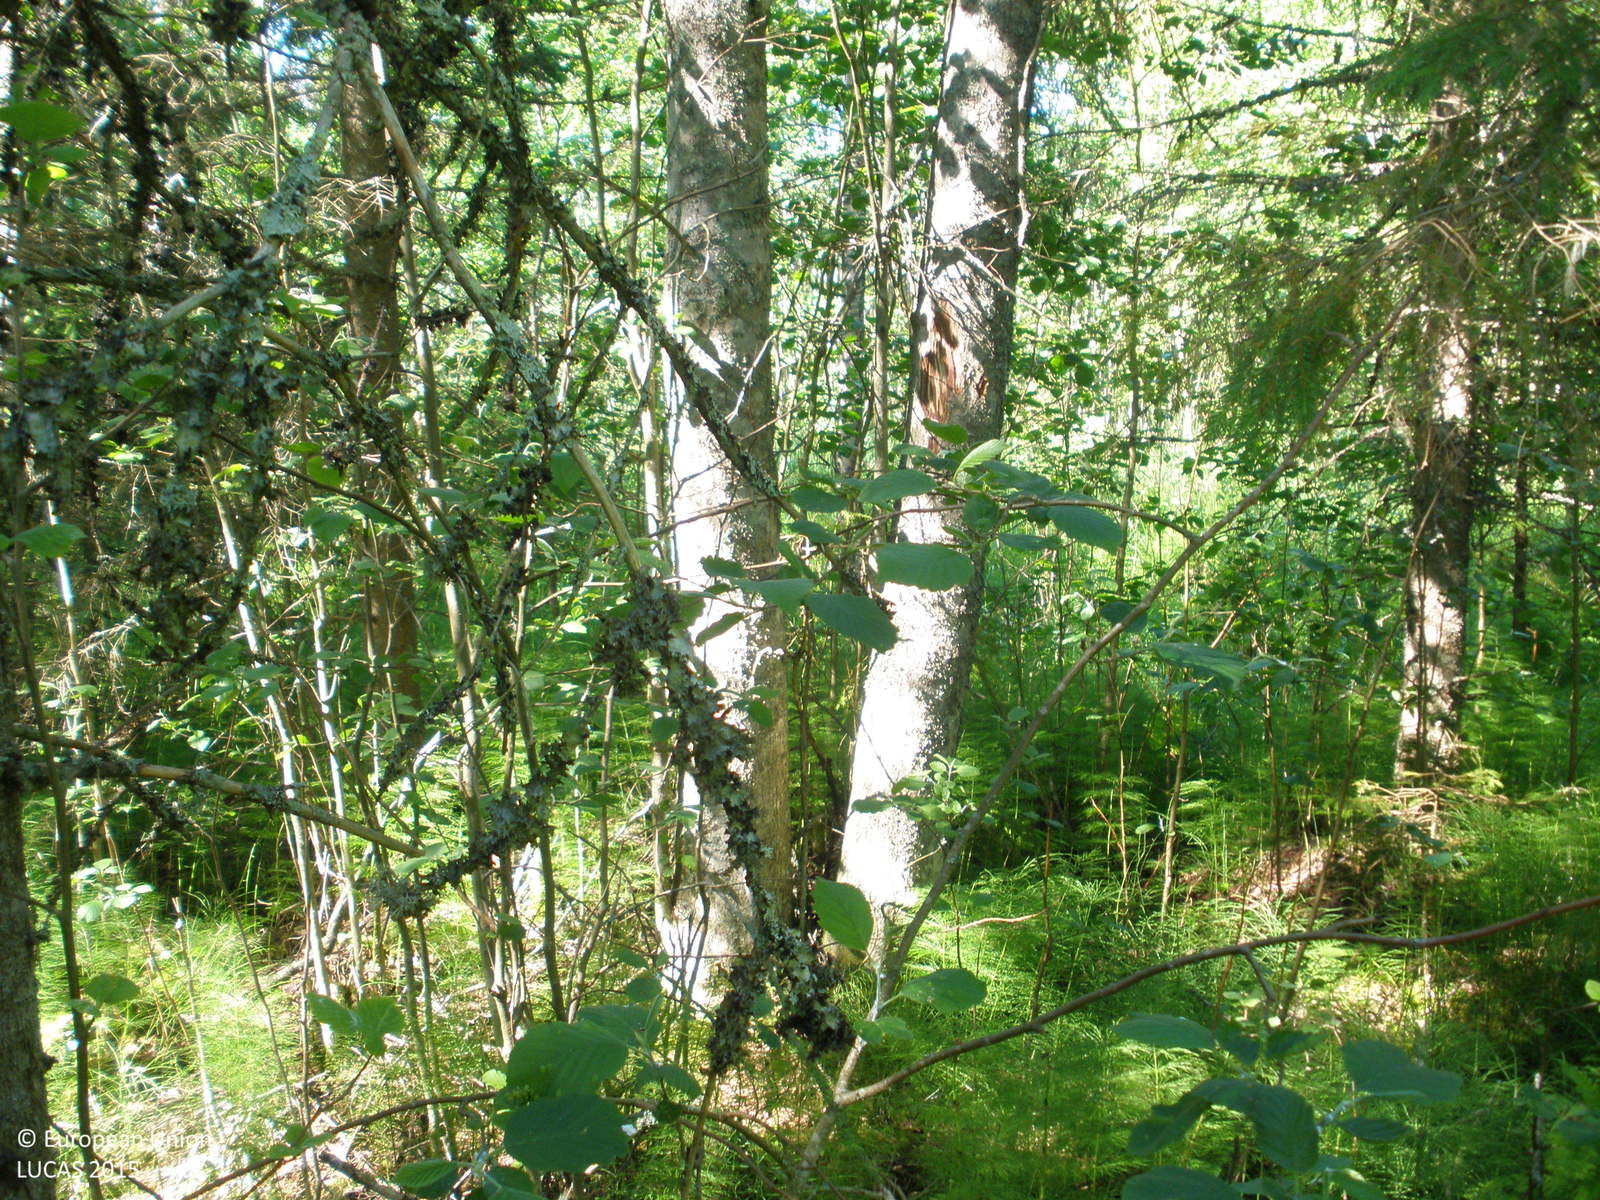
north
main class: Woodland
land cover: Spruce dominated mixed woodland
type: boreal forest
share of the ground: > 75 %
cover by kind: coniferous forest trees 60 %, broadleaved forest trees 25 %, shrubs 5 %, herbaceous plants 5 %, lichens and mosses 5 %
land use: Forestry
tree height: > 5 m
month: July
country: FI
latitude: 61.0999
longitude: 23.7200
